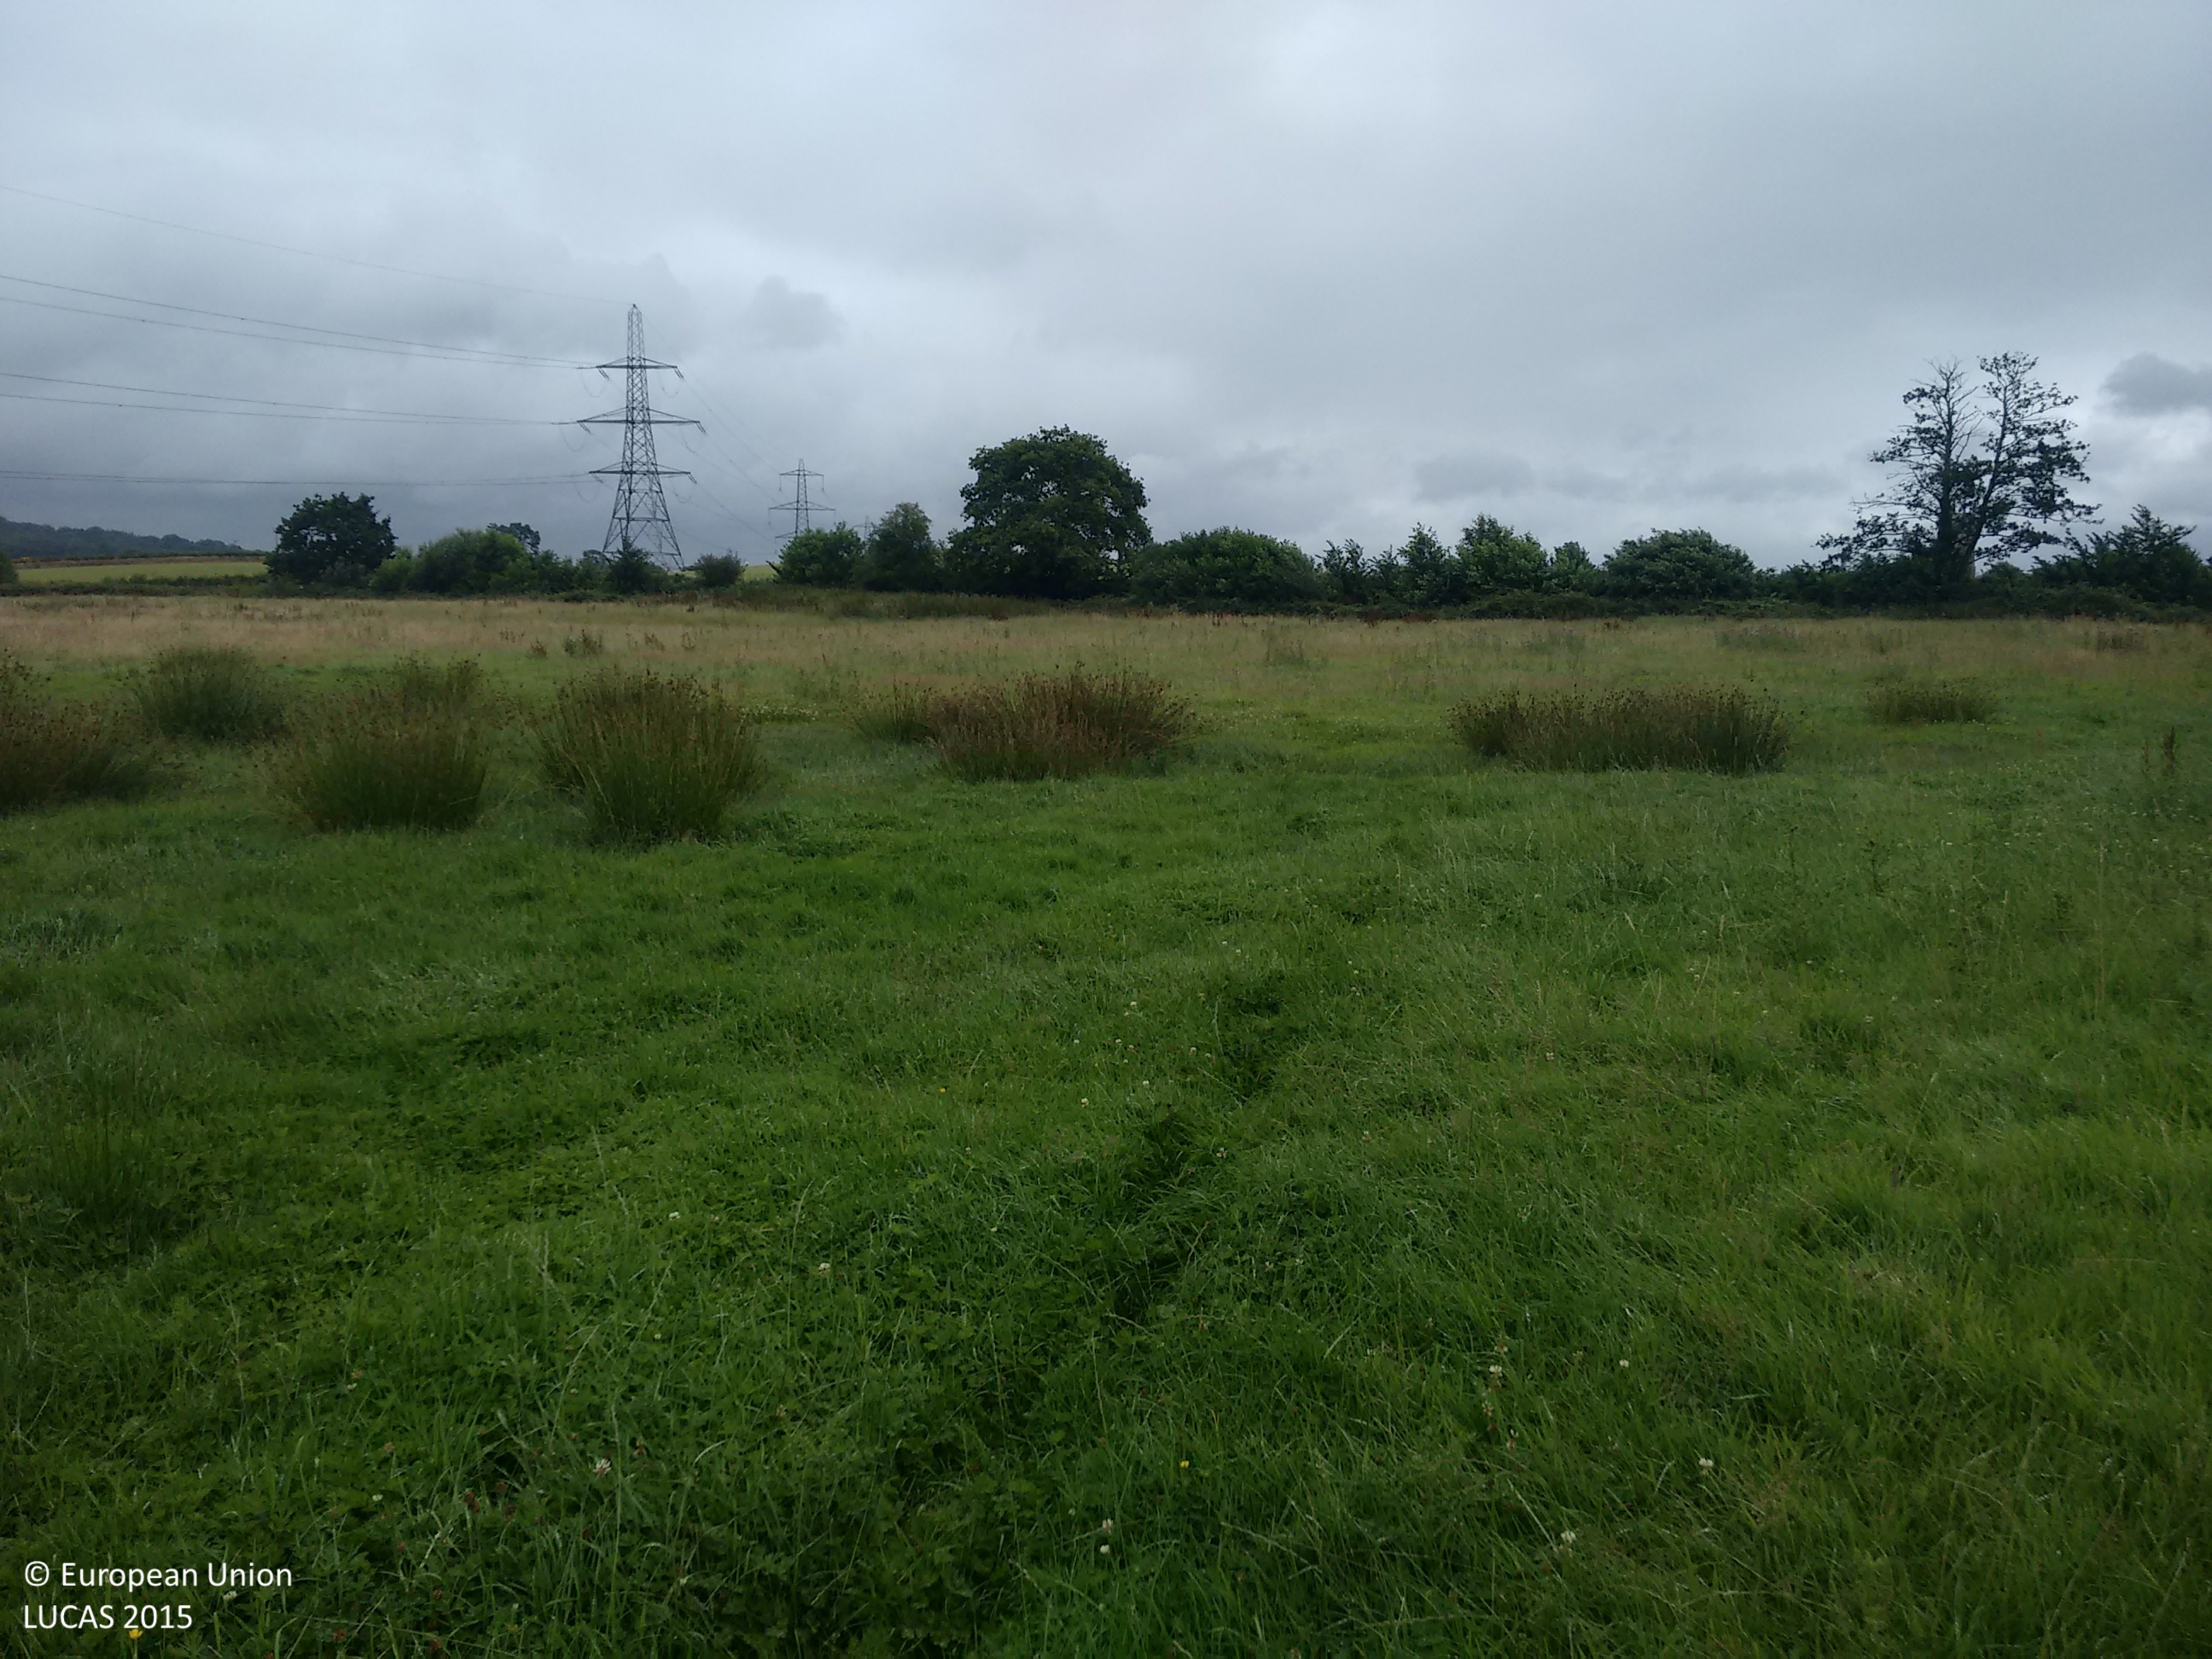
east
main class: Grassland
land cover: Grassland without tree/shrub cover
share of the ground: > 75 %
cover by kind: herbaceous plants 100 %
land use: Agriculture (excluding fallow land and kitchen gardens)
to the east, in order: Grassland without tree/shrub cover; Fences; Shruby margins; Ditches and canals; Broadleaved woodland; Fences; Grassland without tree/shrub cover
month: July
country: GB
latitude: 50.7681
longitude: -3.4539
